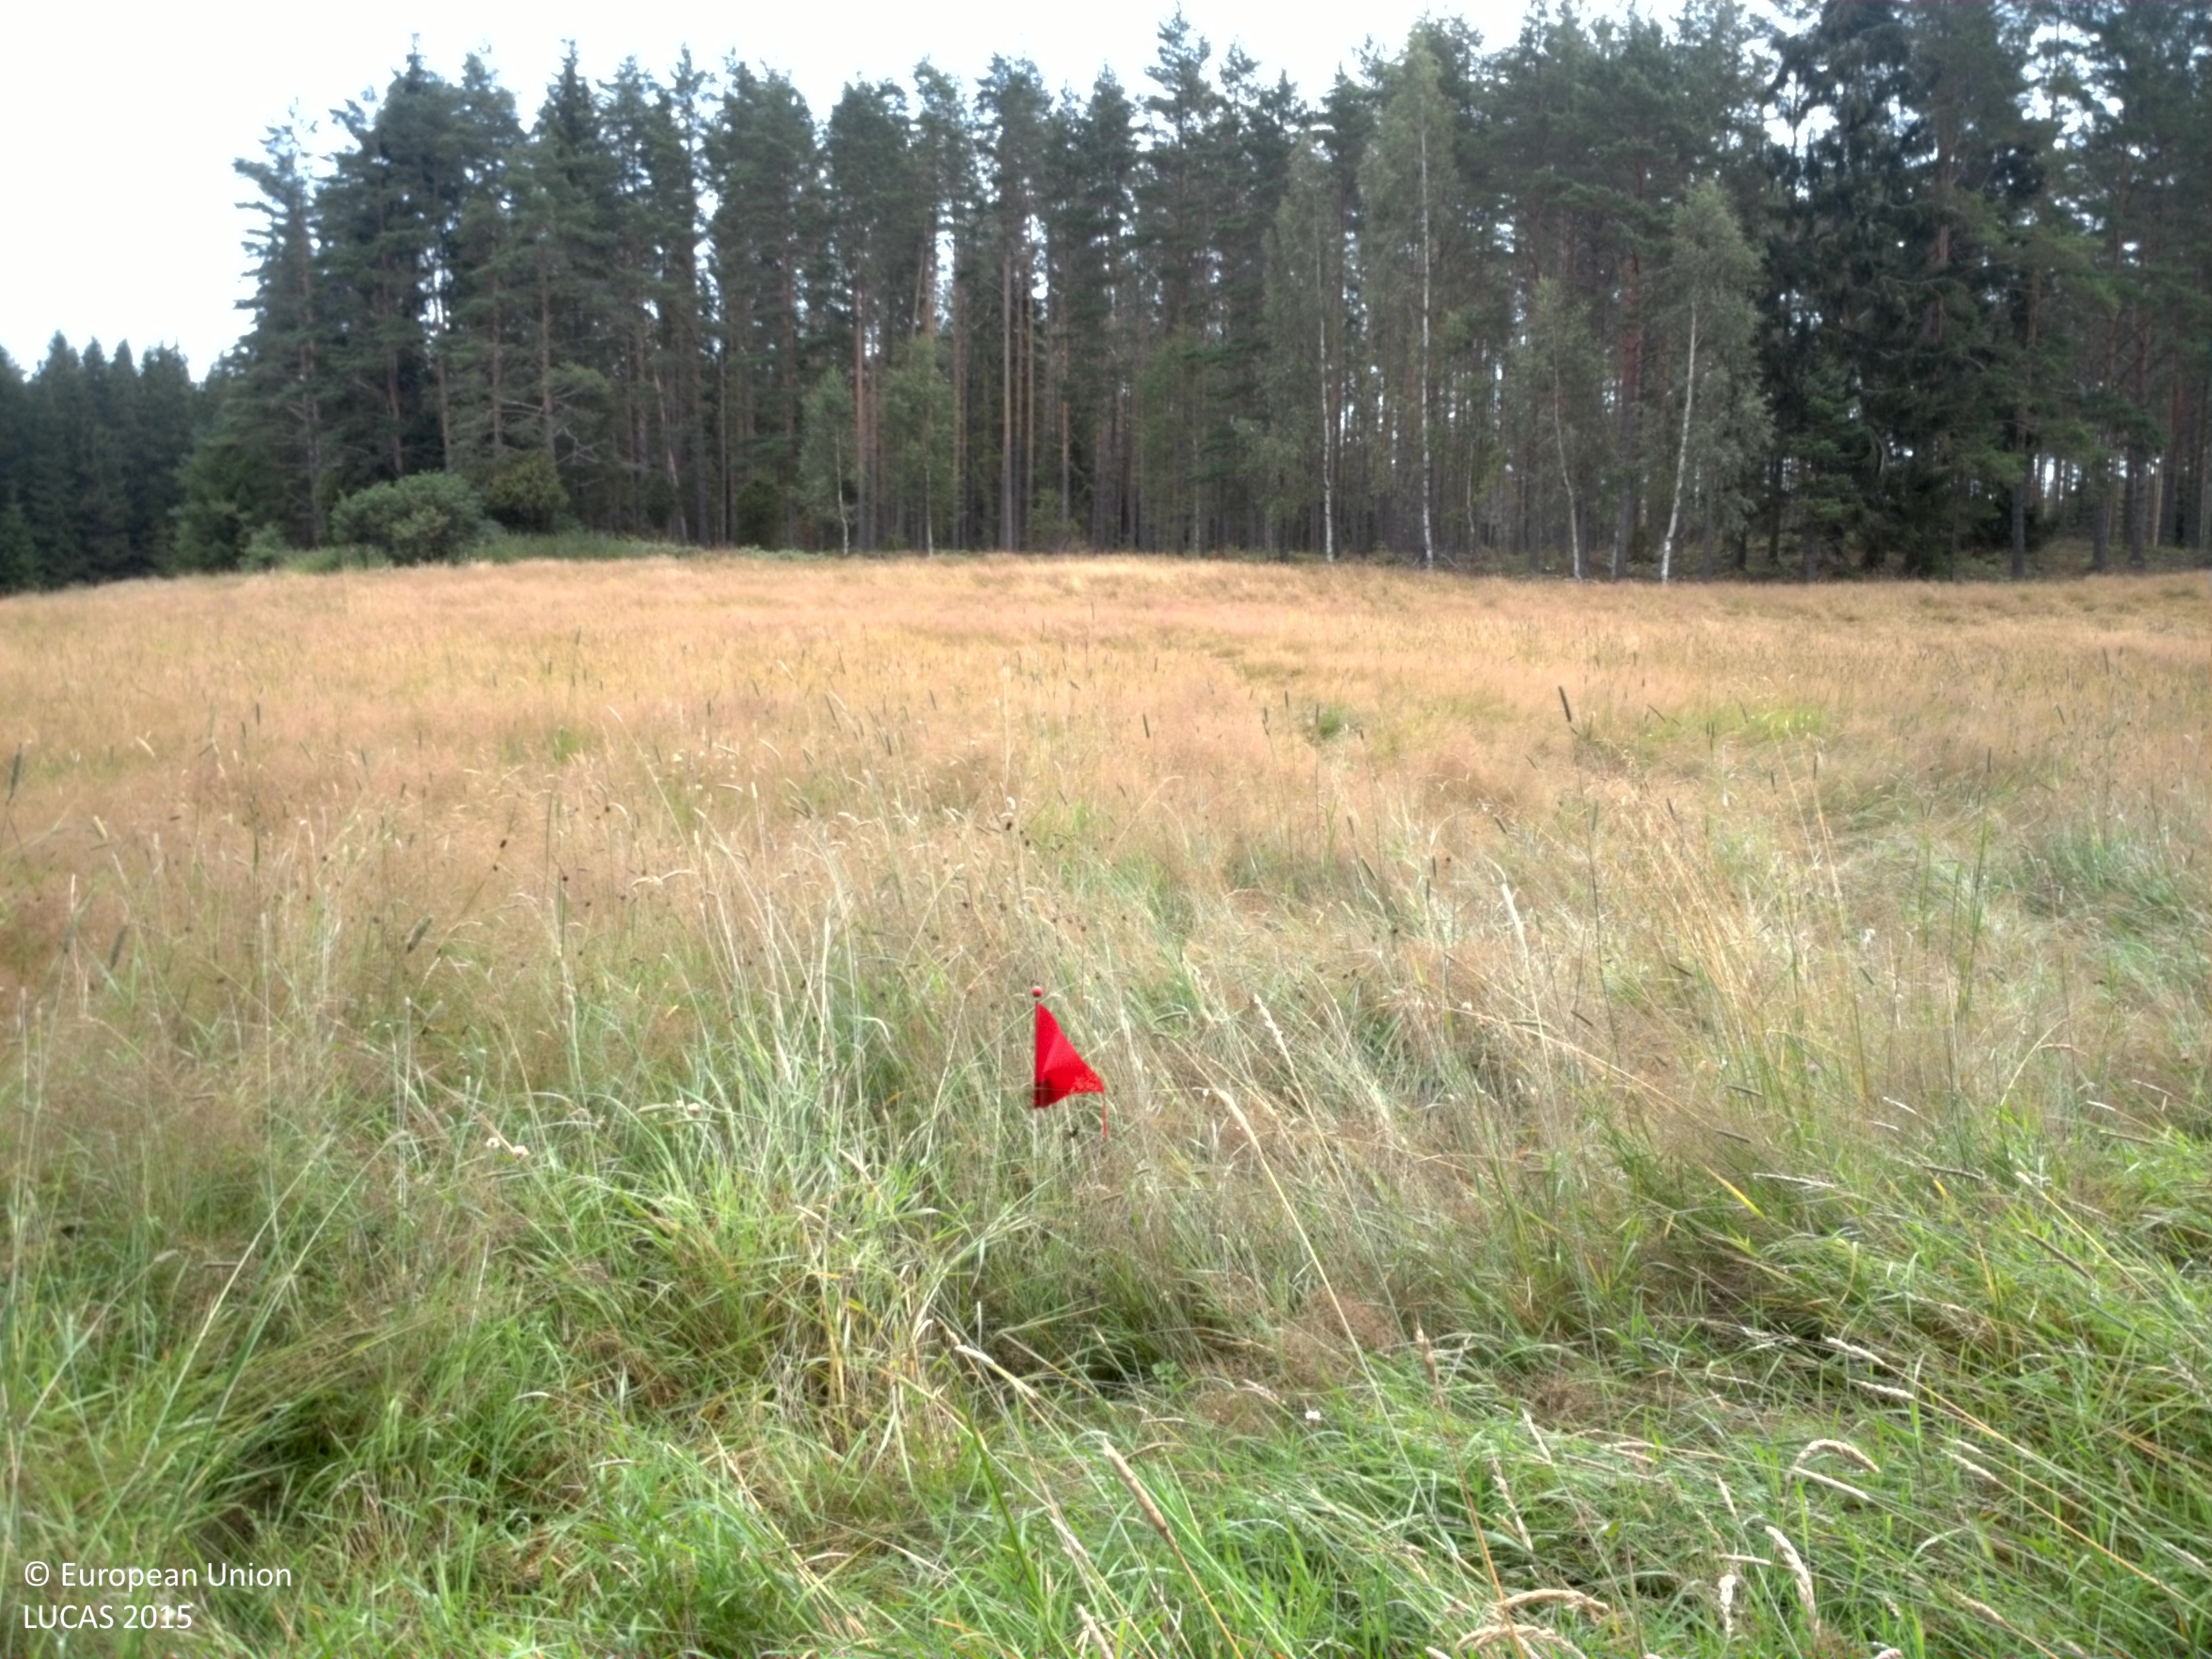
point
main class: Cropland
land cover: Temporary grasslands
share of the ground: > 75 %
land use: Agriculture (excluding fallow land and kitchen gardens)
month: August
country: SE
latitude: 59.3216
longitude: 11.9104
